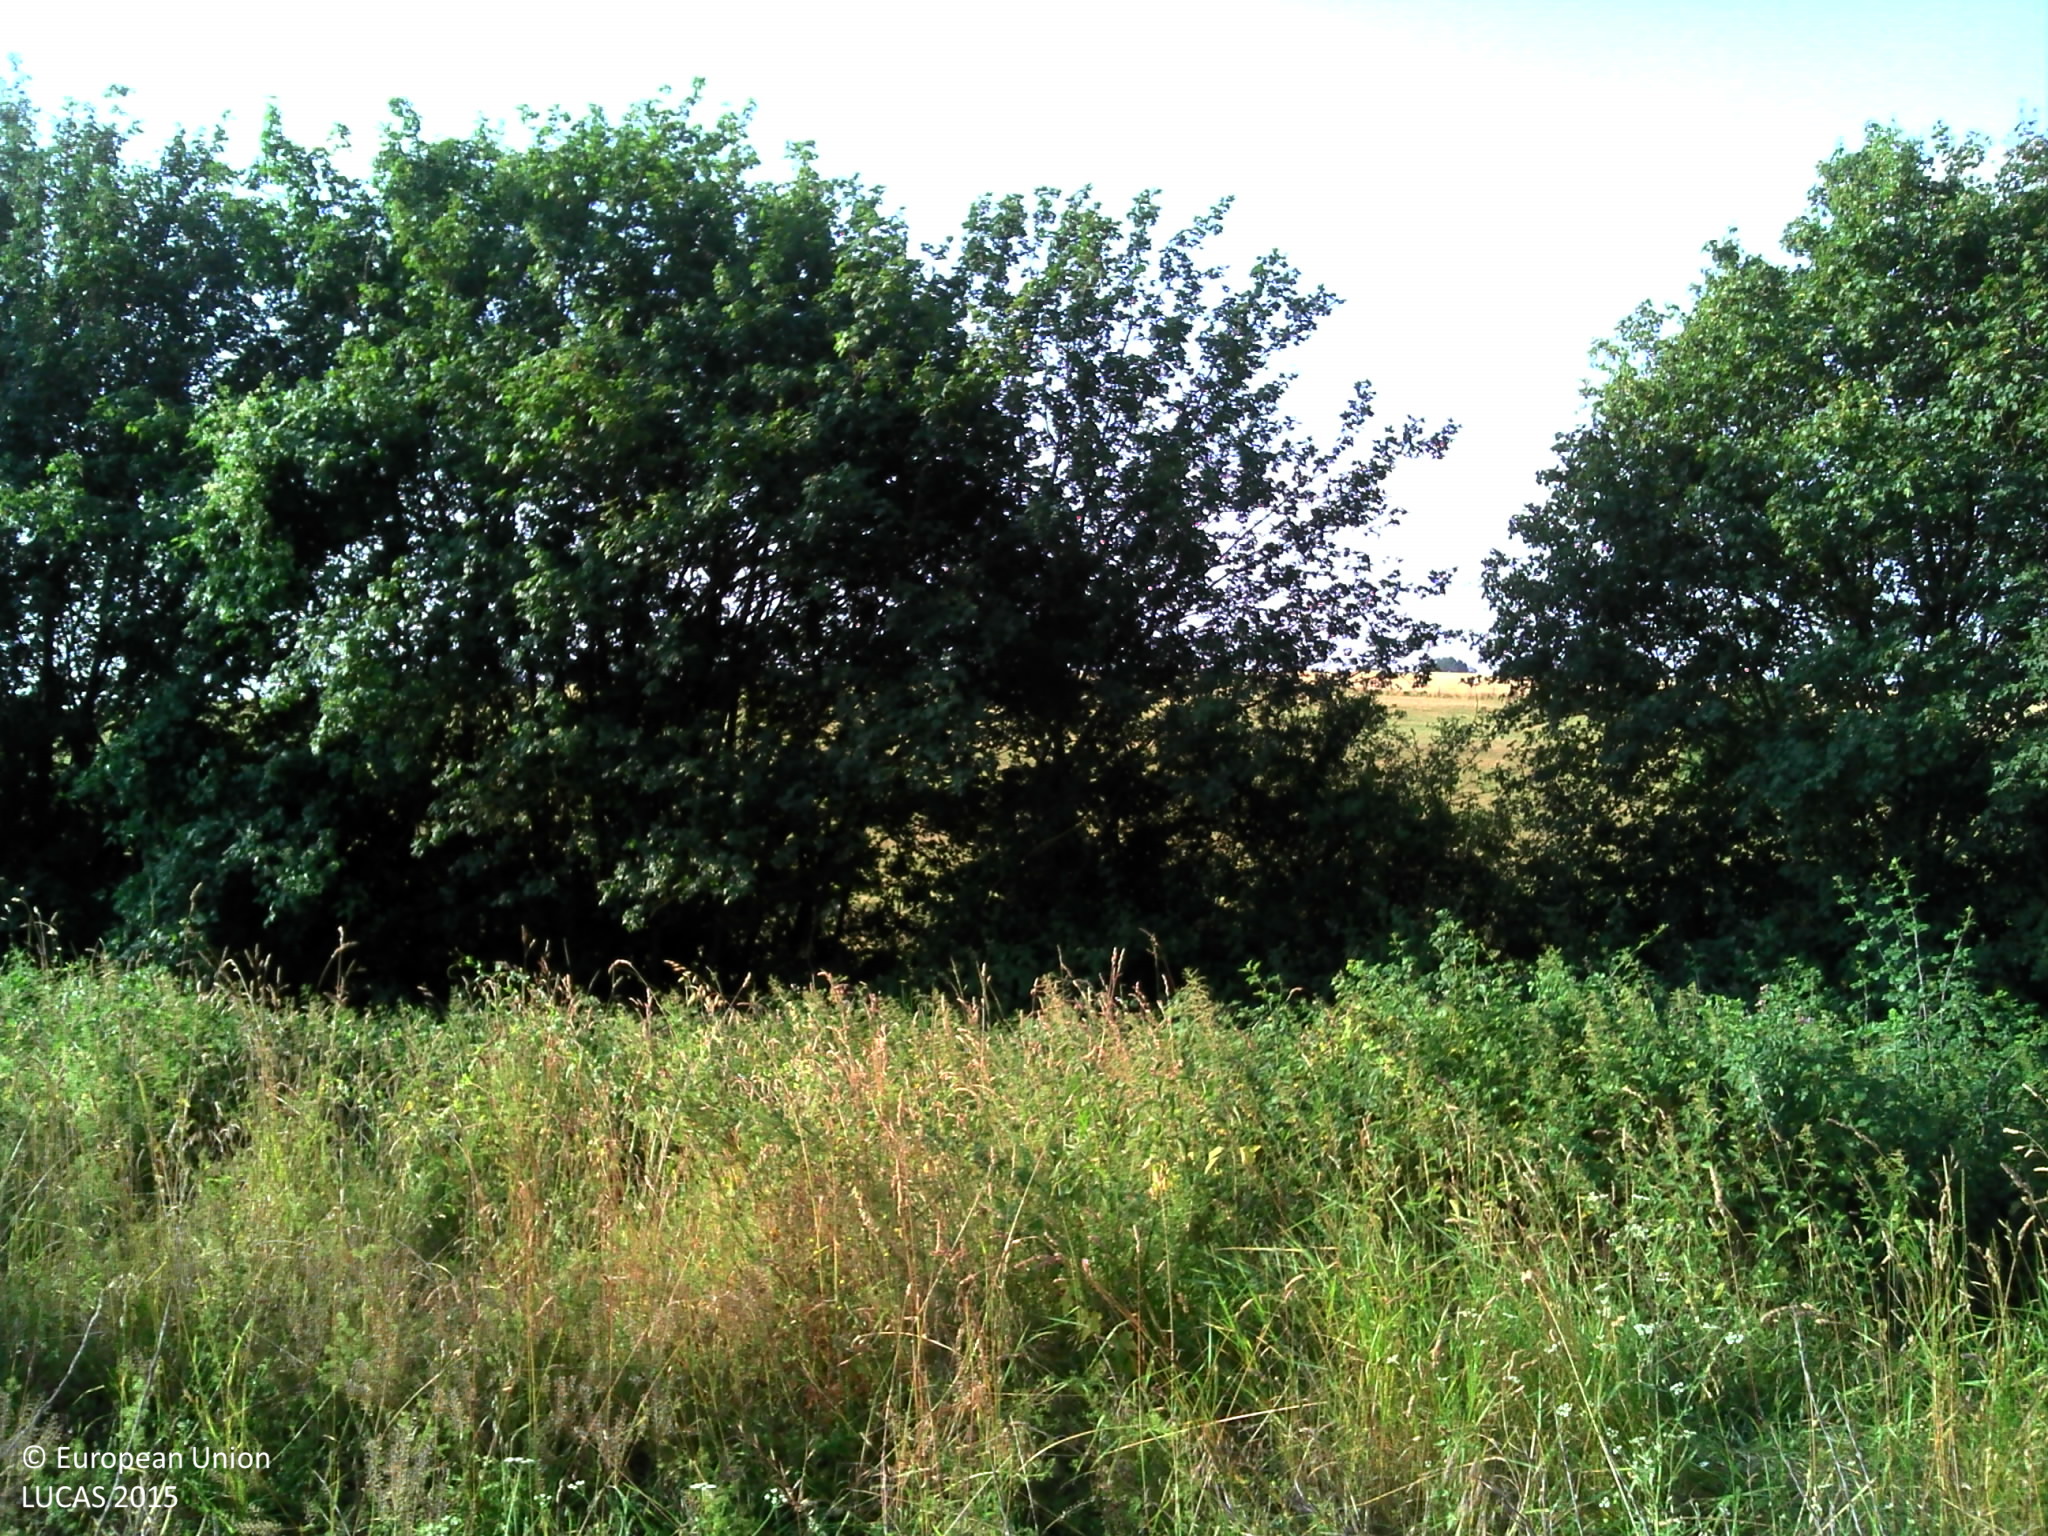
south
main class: Cropland
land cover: Rape and turnip rape
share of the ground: > 75 %
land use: Agriculture (excluding fallow land and kitchen gardens)
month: July
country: FR
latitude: 47.0633
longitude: 3.6119
